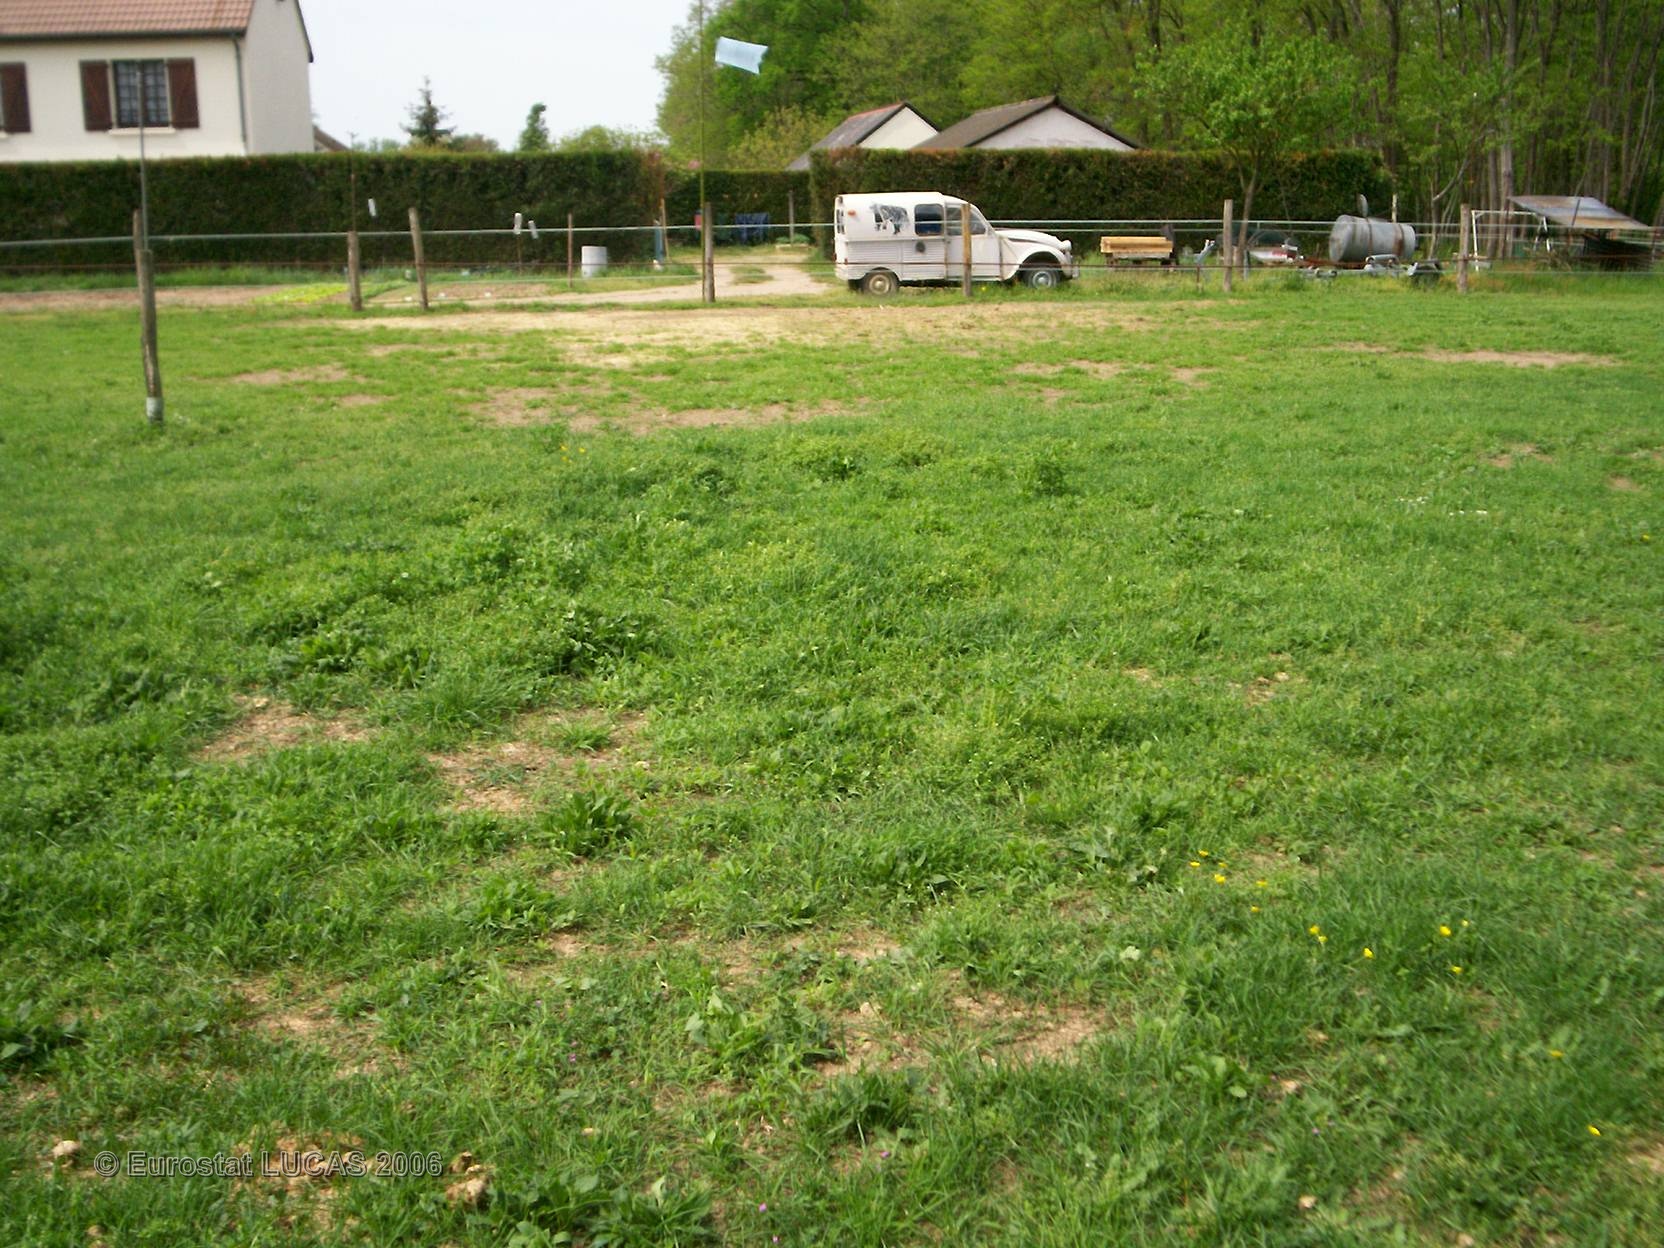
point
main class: Grassland
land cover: Grassland without tree/shrub cover
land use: Agriculture (excluding fallow land and kitchen gardens)
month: May
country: FR
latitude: 47.3156
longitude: 0.4139
